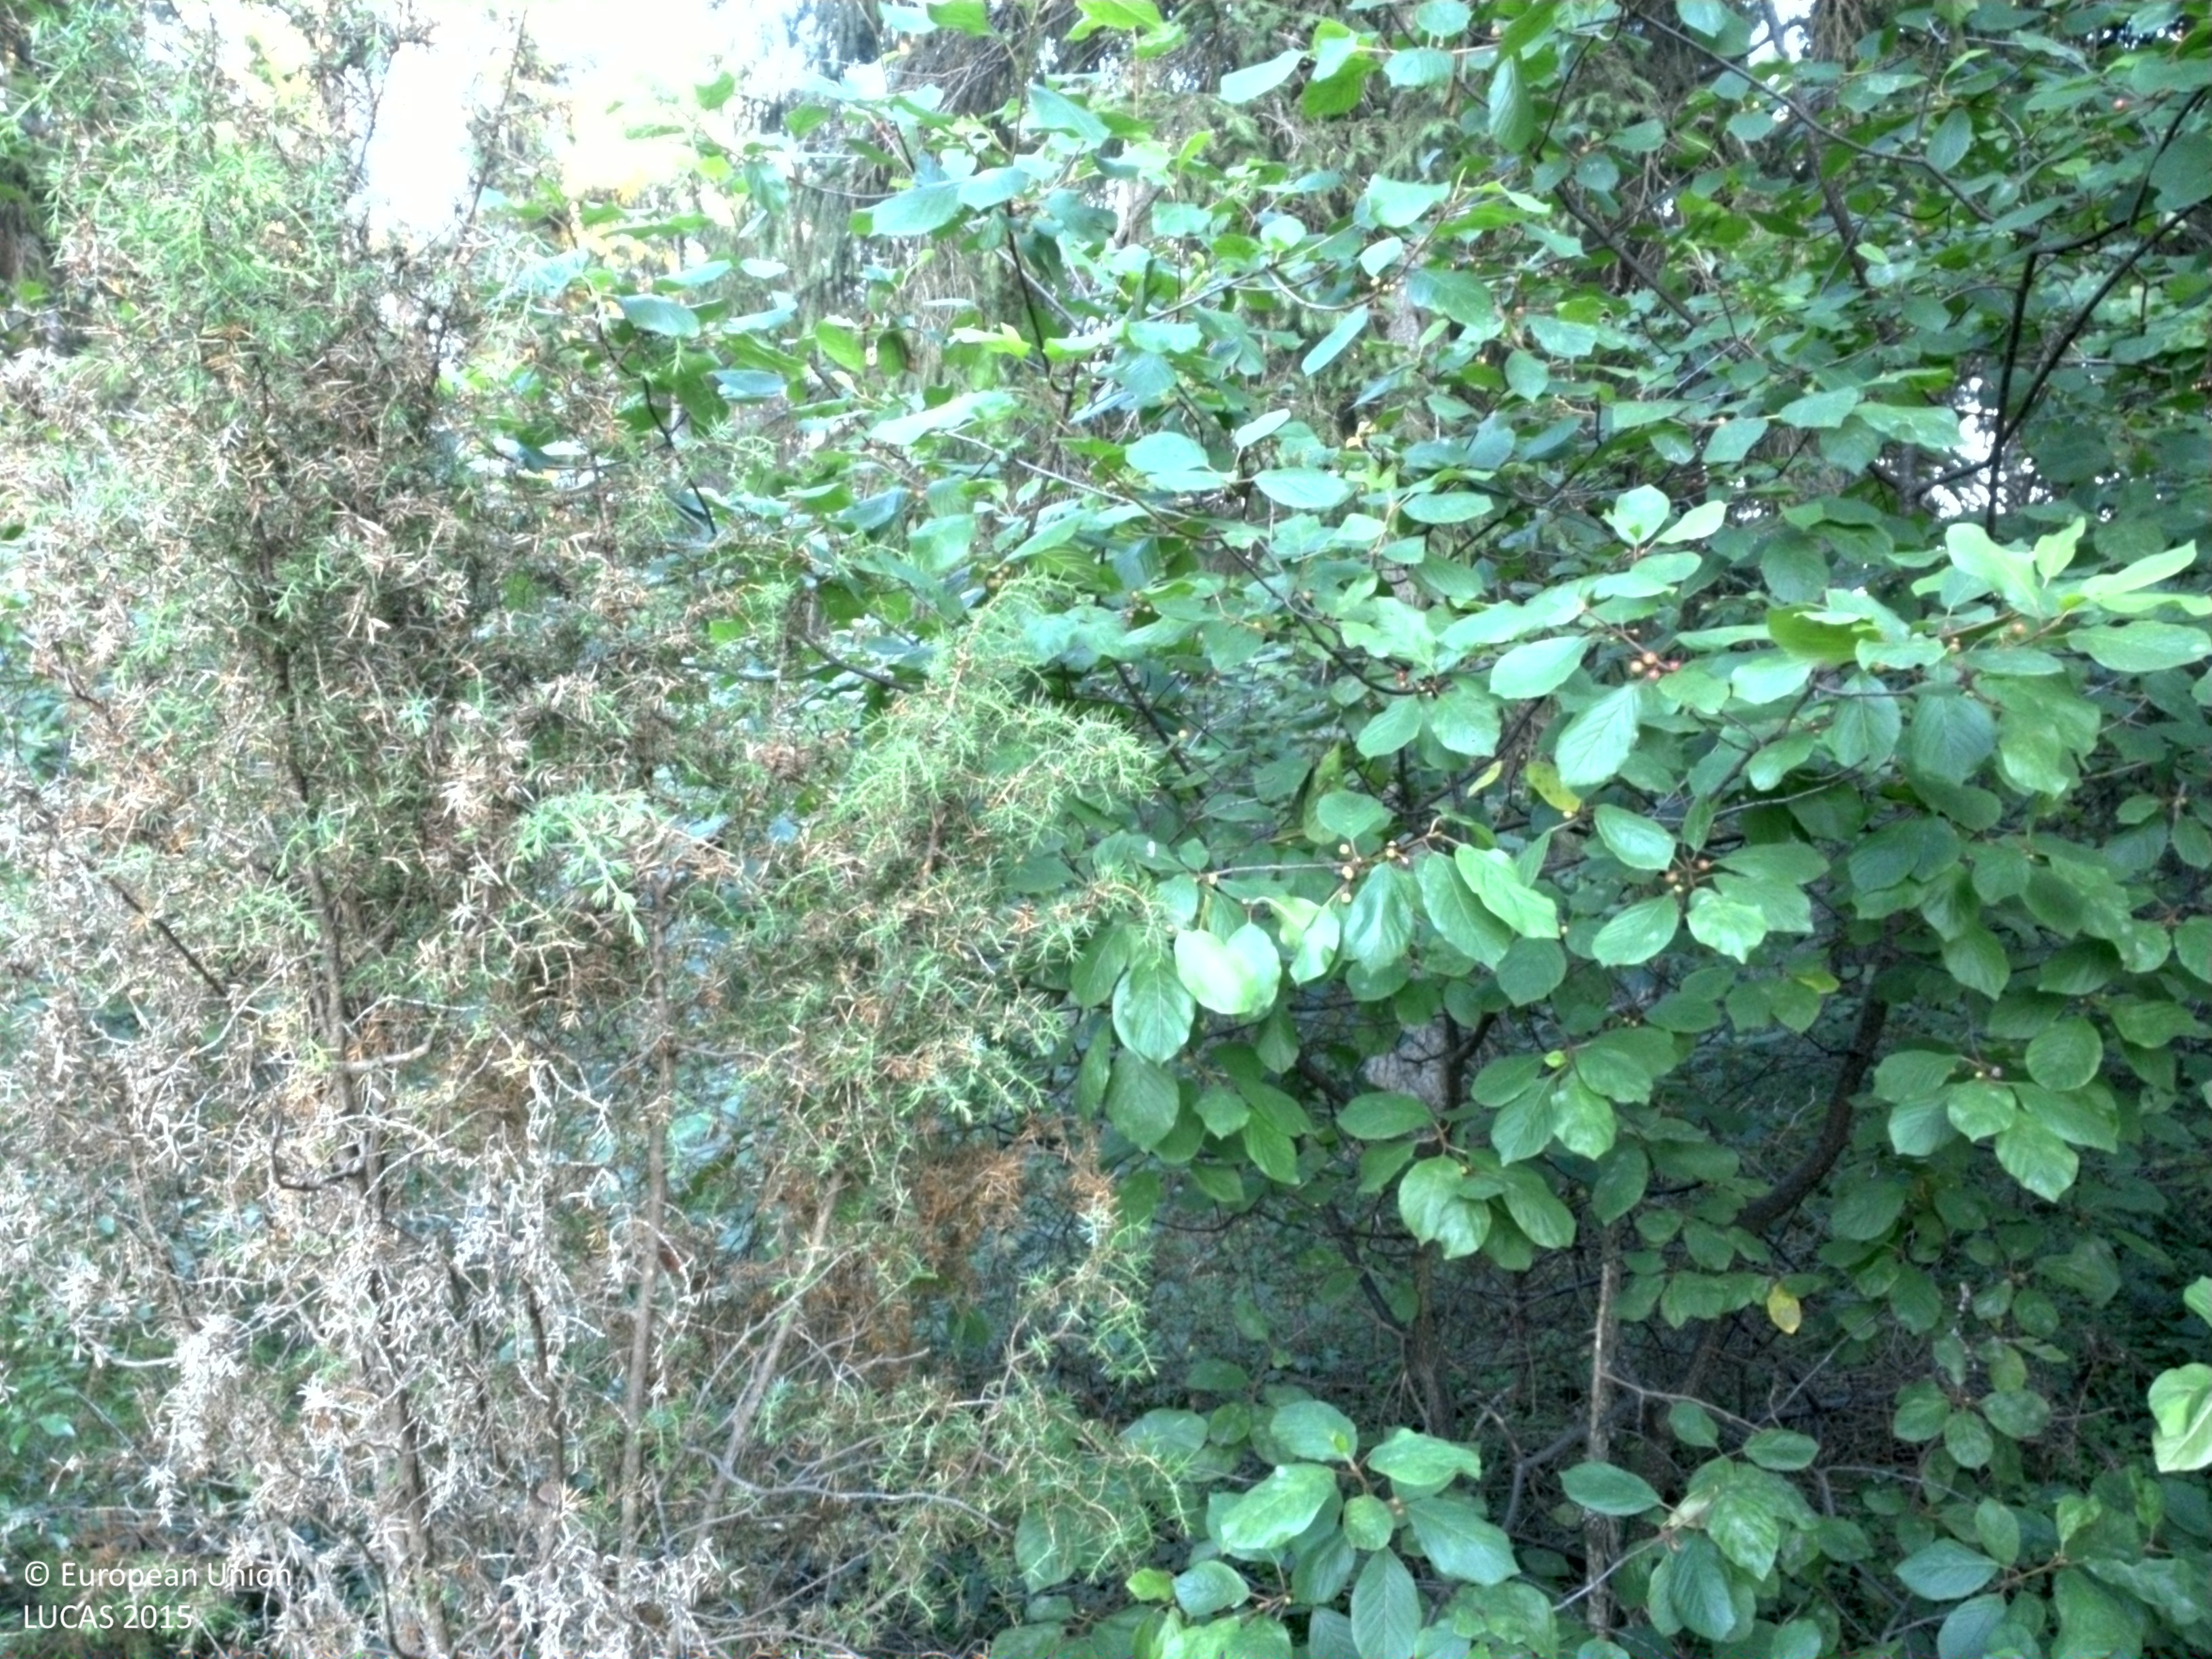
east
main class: Woodland
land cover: Pine dominated coniferous woodland
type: hemiboreal forest and nemoral coniferous forest and mixed broadleaved-coniferous forest
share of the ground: 50 - 75 %
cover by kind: coniferous forest trees 55 %, shrubs 20 %, herbaceous plants 20 %, broadleaved forest trees 5 %
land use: Forestry
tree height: > 5 m
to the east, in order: Pine dominated coniferous woodland; Spruce dominated coniferous woodland; Pine dominated coniferous woodland; Pine dominated mixed woodland; Tracks; Pine dominated mixed woodland
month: July
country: SE
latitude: 57.3191
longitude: 18.4611
